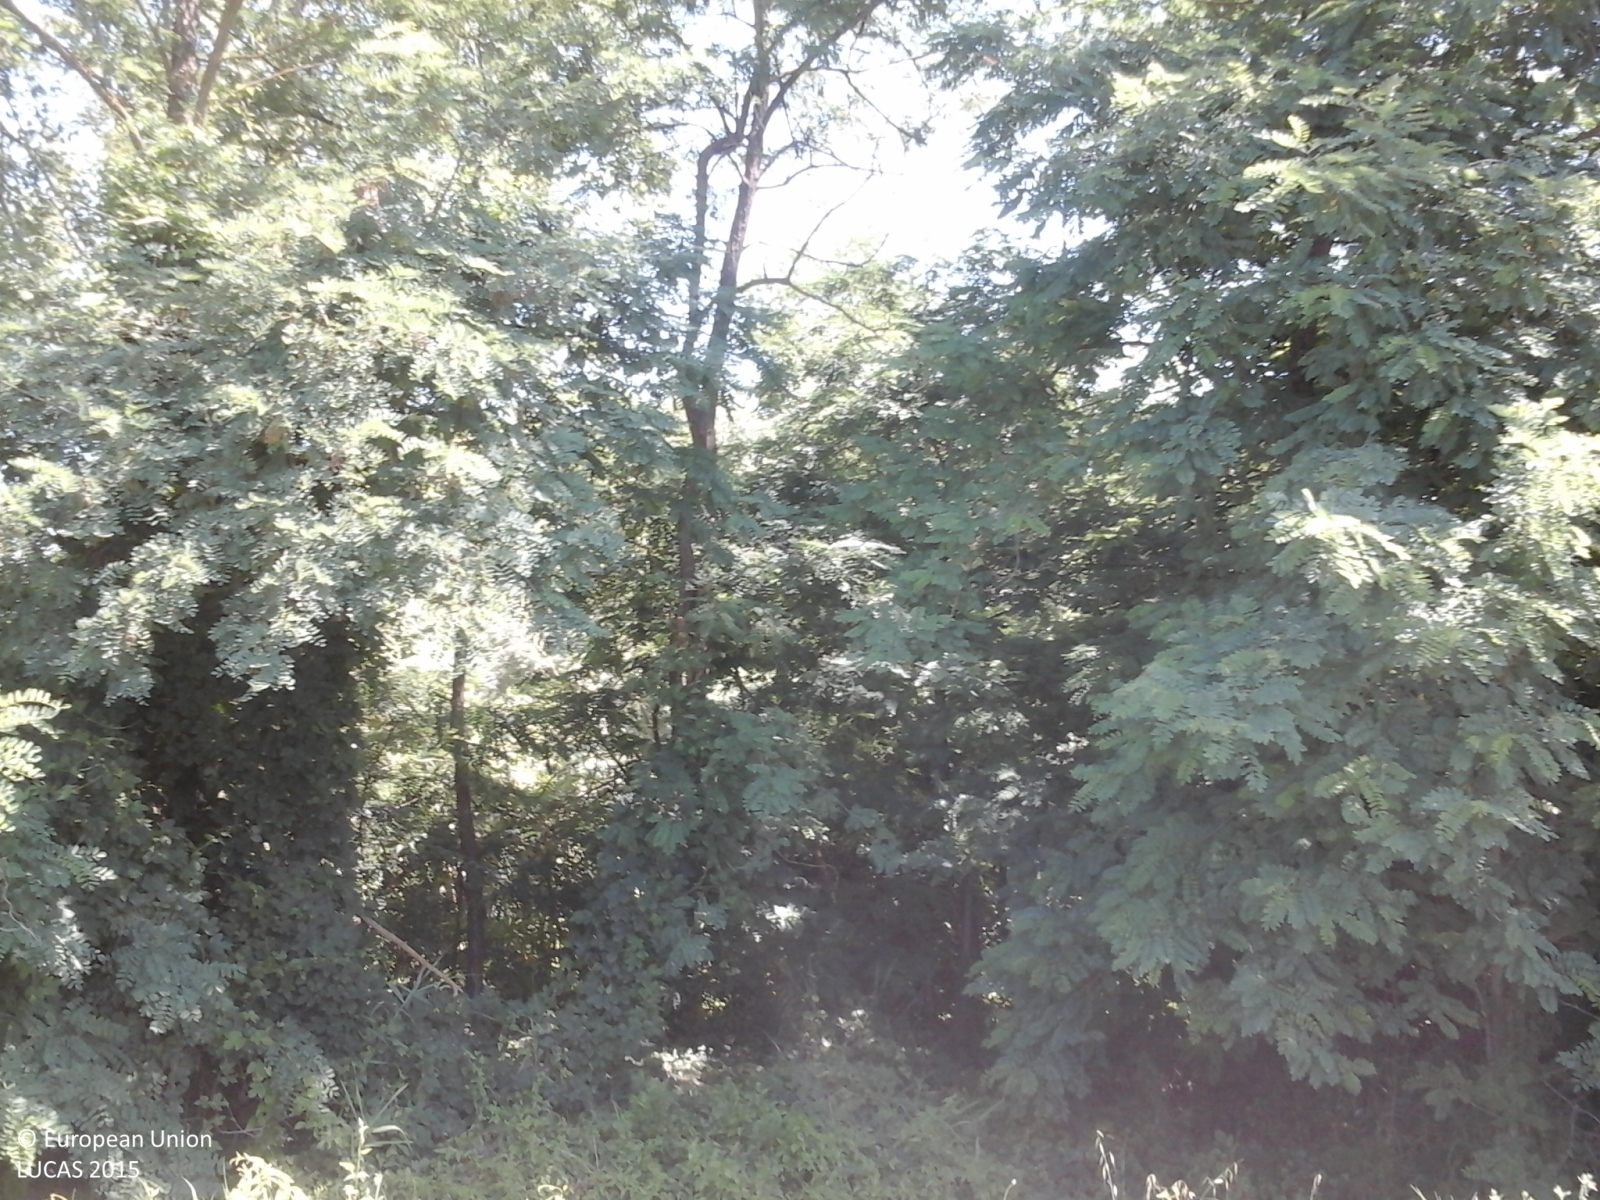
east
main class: Cropland
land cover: Durum wheat
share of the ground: > 75 %
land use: Agriculture (excluding fallow land and kitchen gardens)
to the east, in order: Durum wheat; Shruby margins; Tracks; Shruby margins; Grassland with sparse tree/shrub cover; Broadleaved woodland; Inland fresh running water; Broadleaved woodland; Artificial constructions in urban areas; Barley
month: June
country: IT
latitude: 43.6245
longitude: 10.9517
